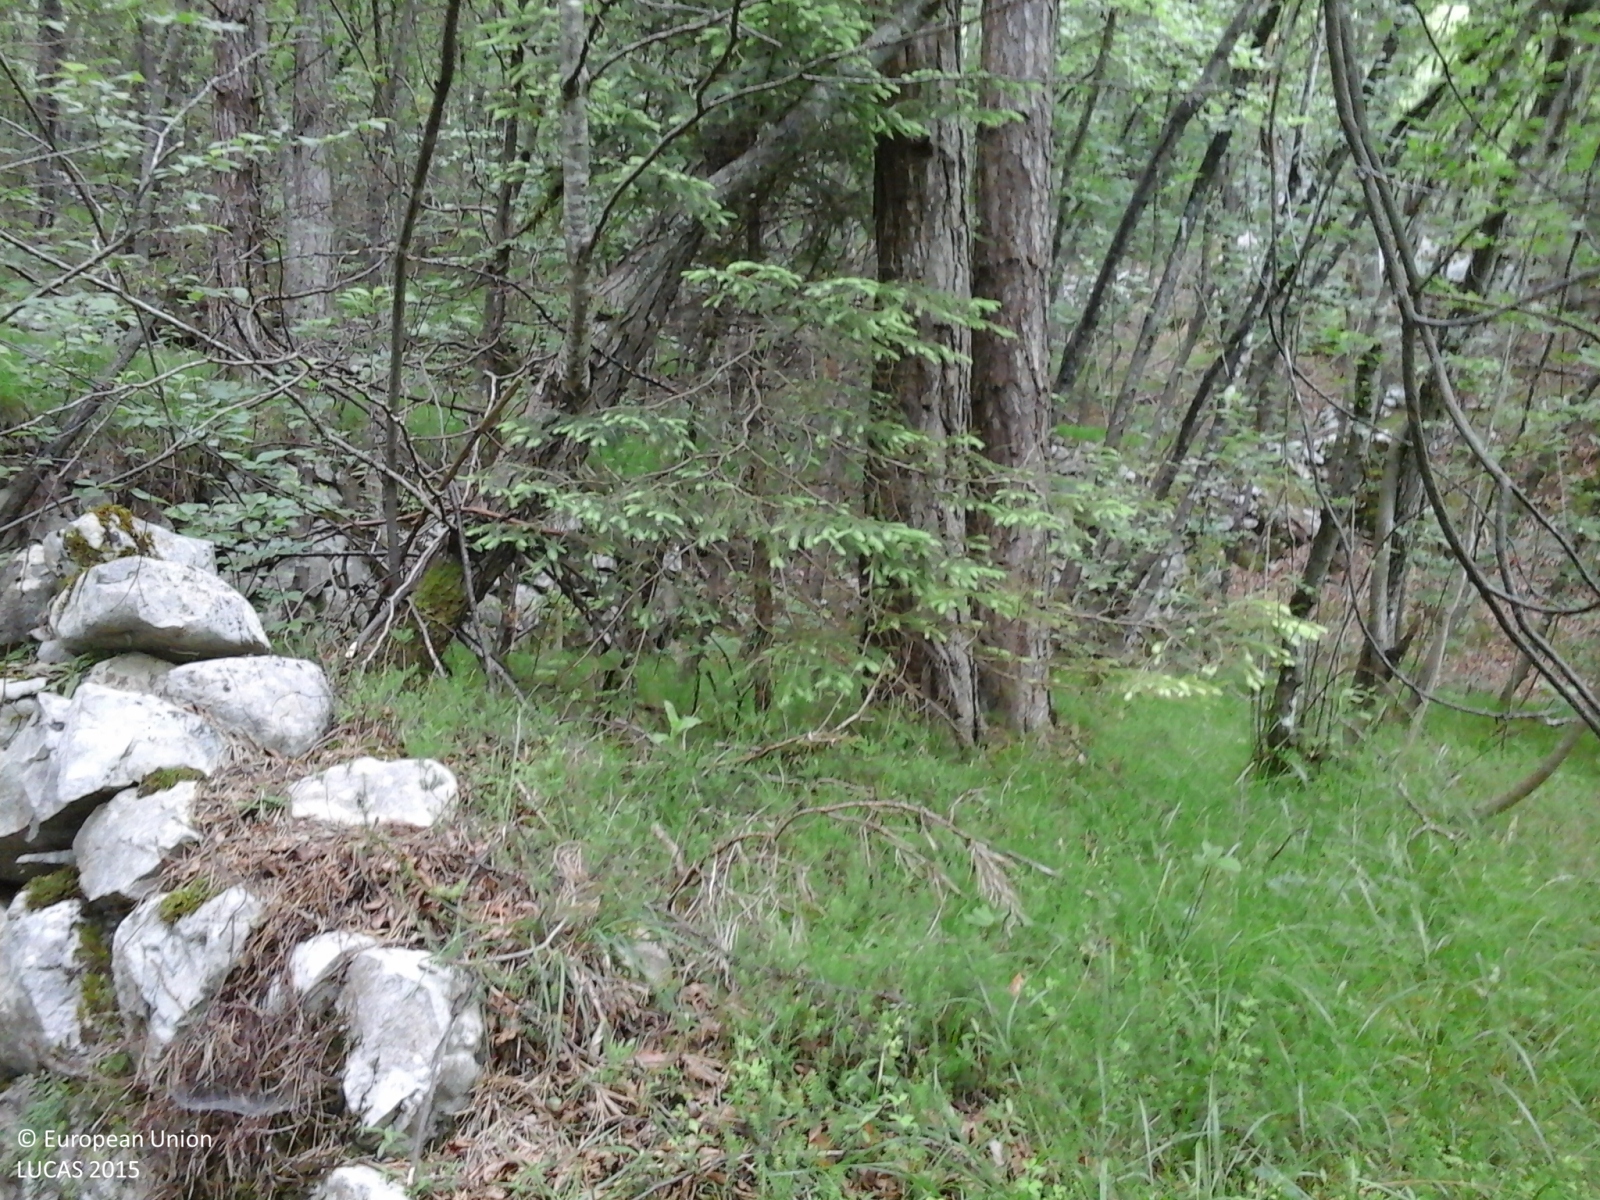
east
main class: Woodland
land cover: Broadleaved woodland
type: thermophilous deciduous forest
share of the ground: > 75 %
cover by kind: broadleaved forest trees 90 %, coniferous forest trees 10 %
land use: Semi-natural and natural areas not in use
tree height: > 5 m
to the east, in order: Broadleaved woodland
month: June
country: IT
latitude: 46.1820
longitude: 12.3161
